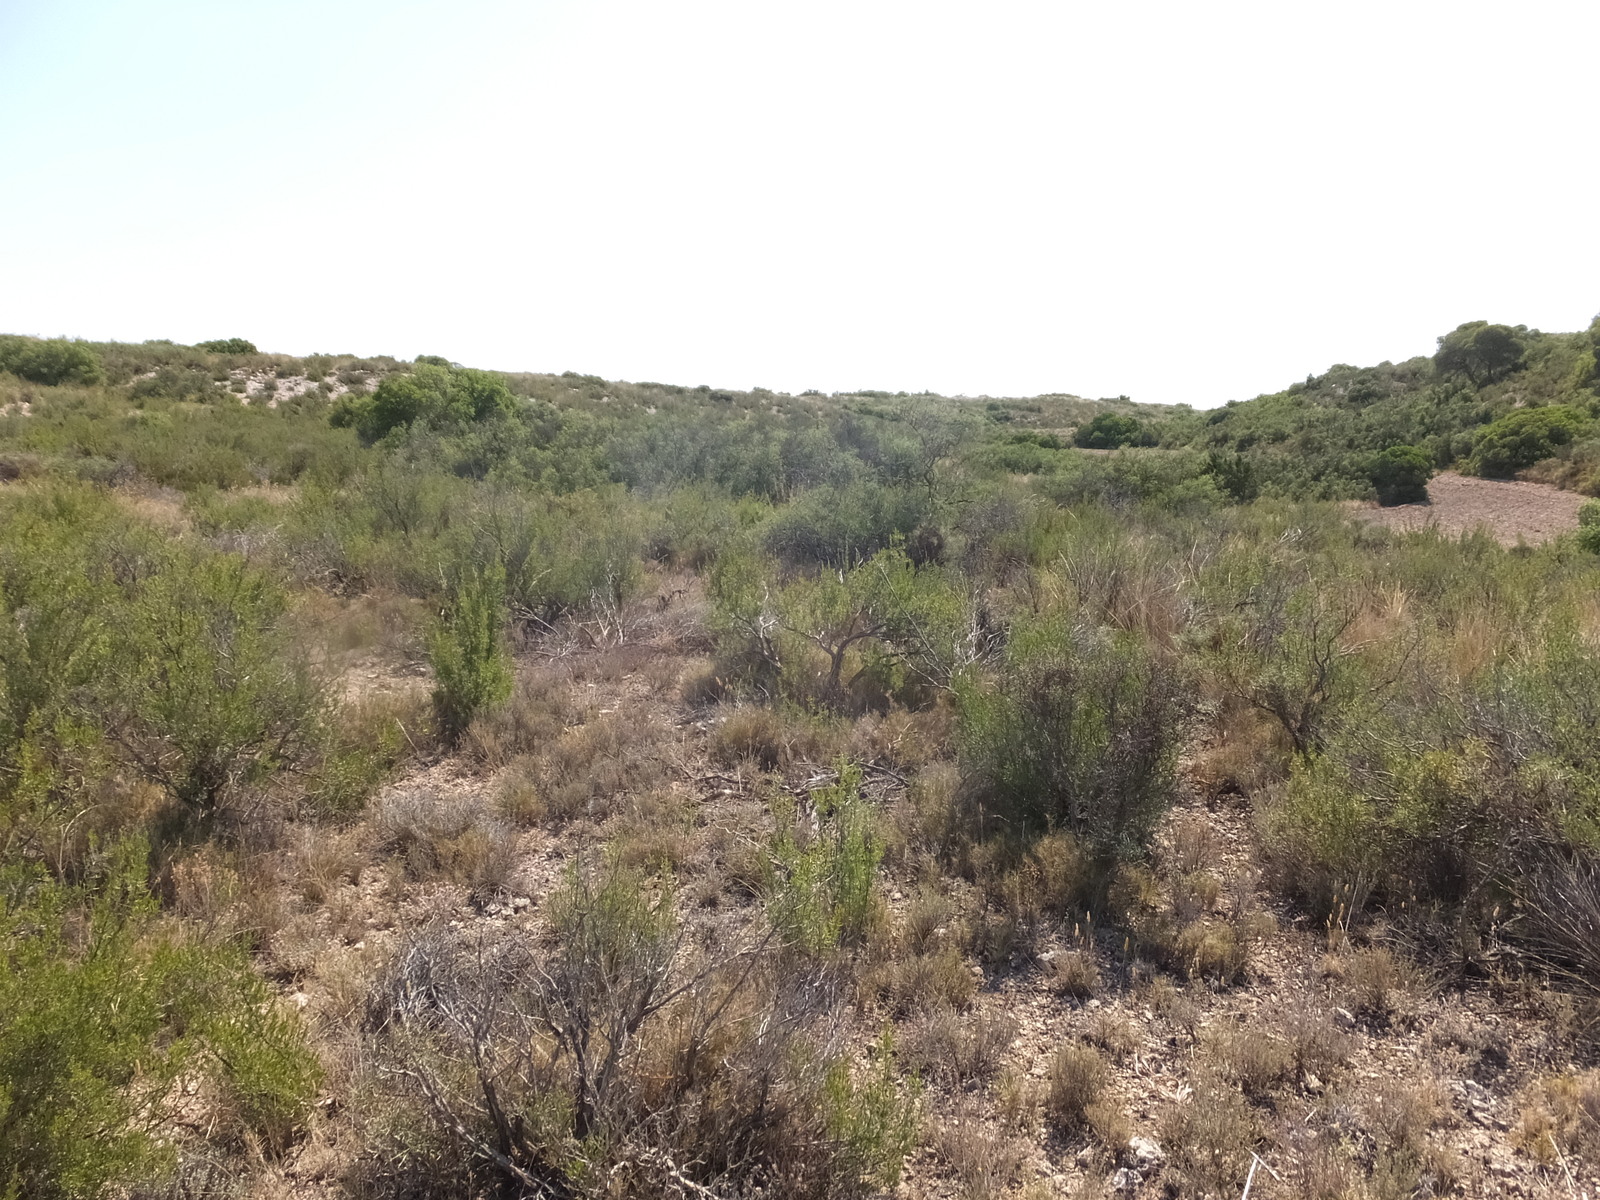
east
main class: Shrubland
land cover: Shrubland with sparse tree cover
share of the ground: > 75 %
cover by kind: shrubs 70 %, herbaceous plants 25 %, coniferous forest trees 5 %
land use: Semi-natural and natural areas not in use
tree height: < 5 m
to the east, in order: Shrubland with sparse tree cover; Other bare soil; Shrubland with sparse tree cover
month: June
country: ES
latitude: 41.3843
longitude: -0.0949
